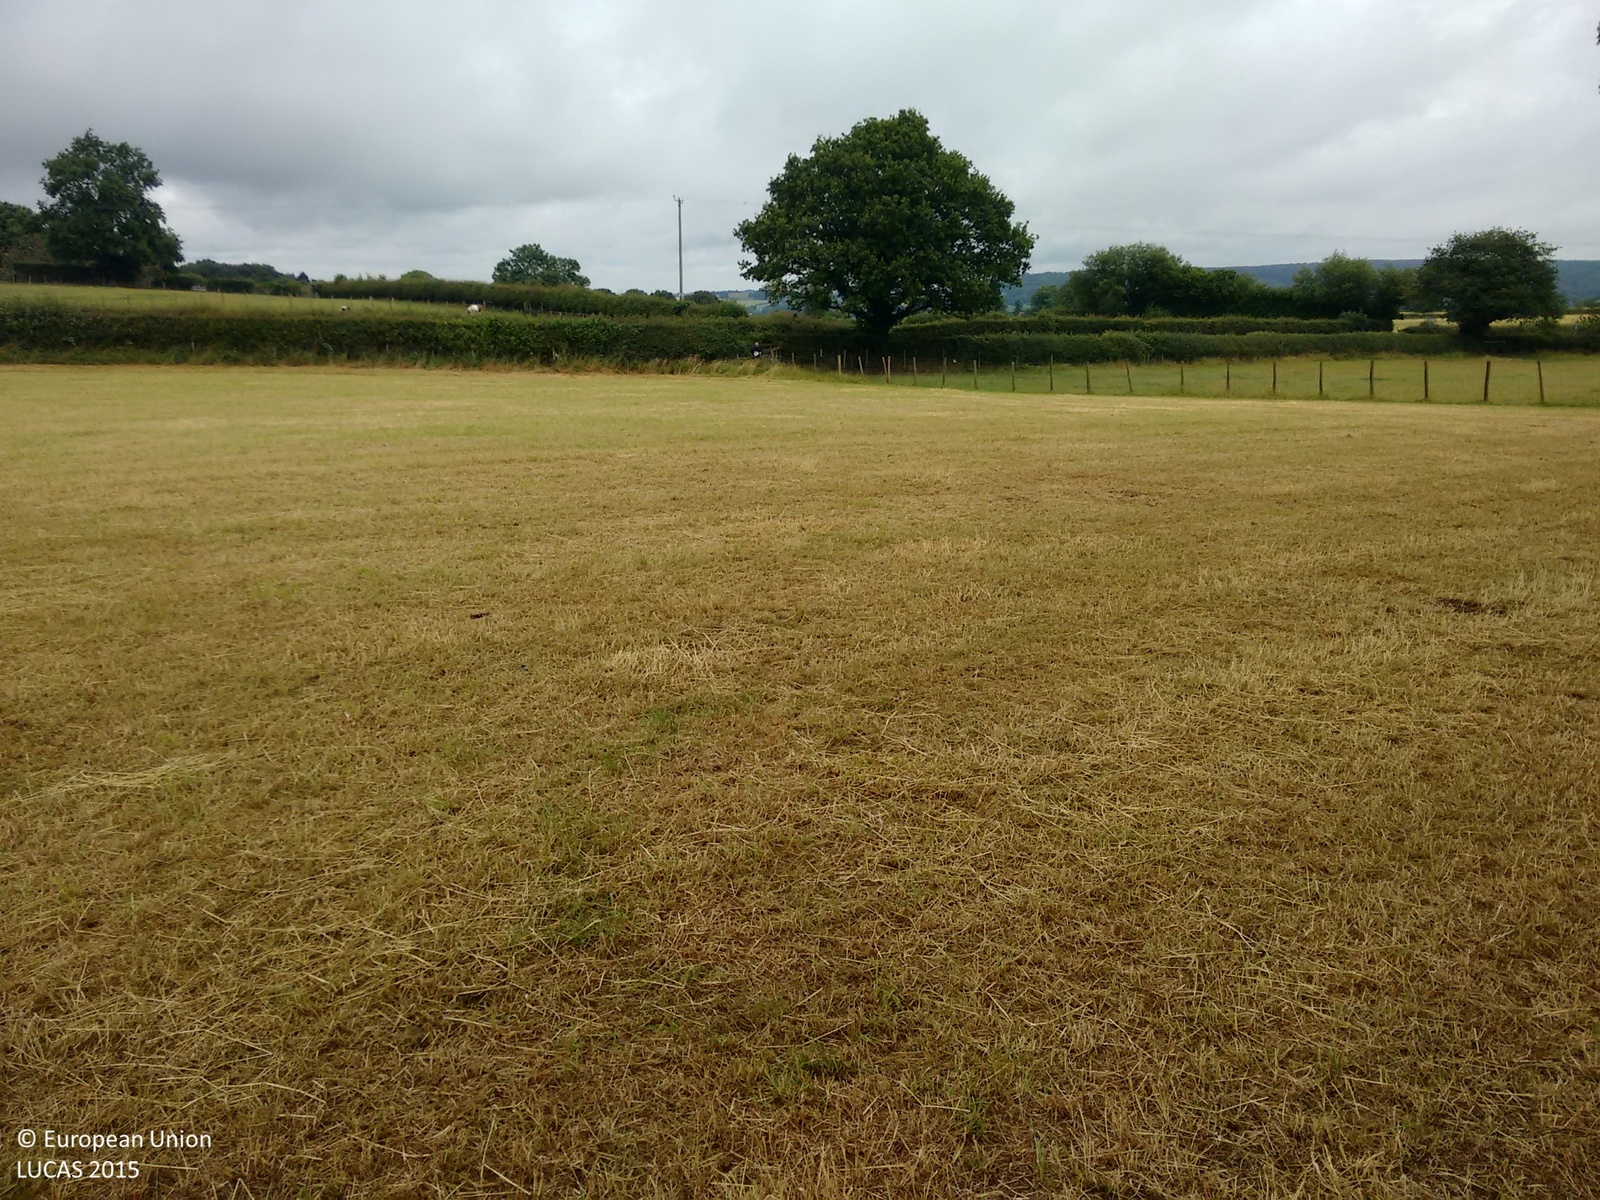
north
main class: Grassland
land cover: Grassland without tree/shrub cover
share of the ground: > 75 %
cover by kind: herbaceous plants 100 %
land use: Agriculture (excluding fallow land and kitchen gardens)
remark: Harvested field
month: July
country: GB
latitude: 52.9288
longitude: -2.3664
